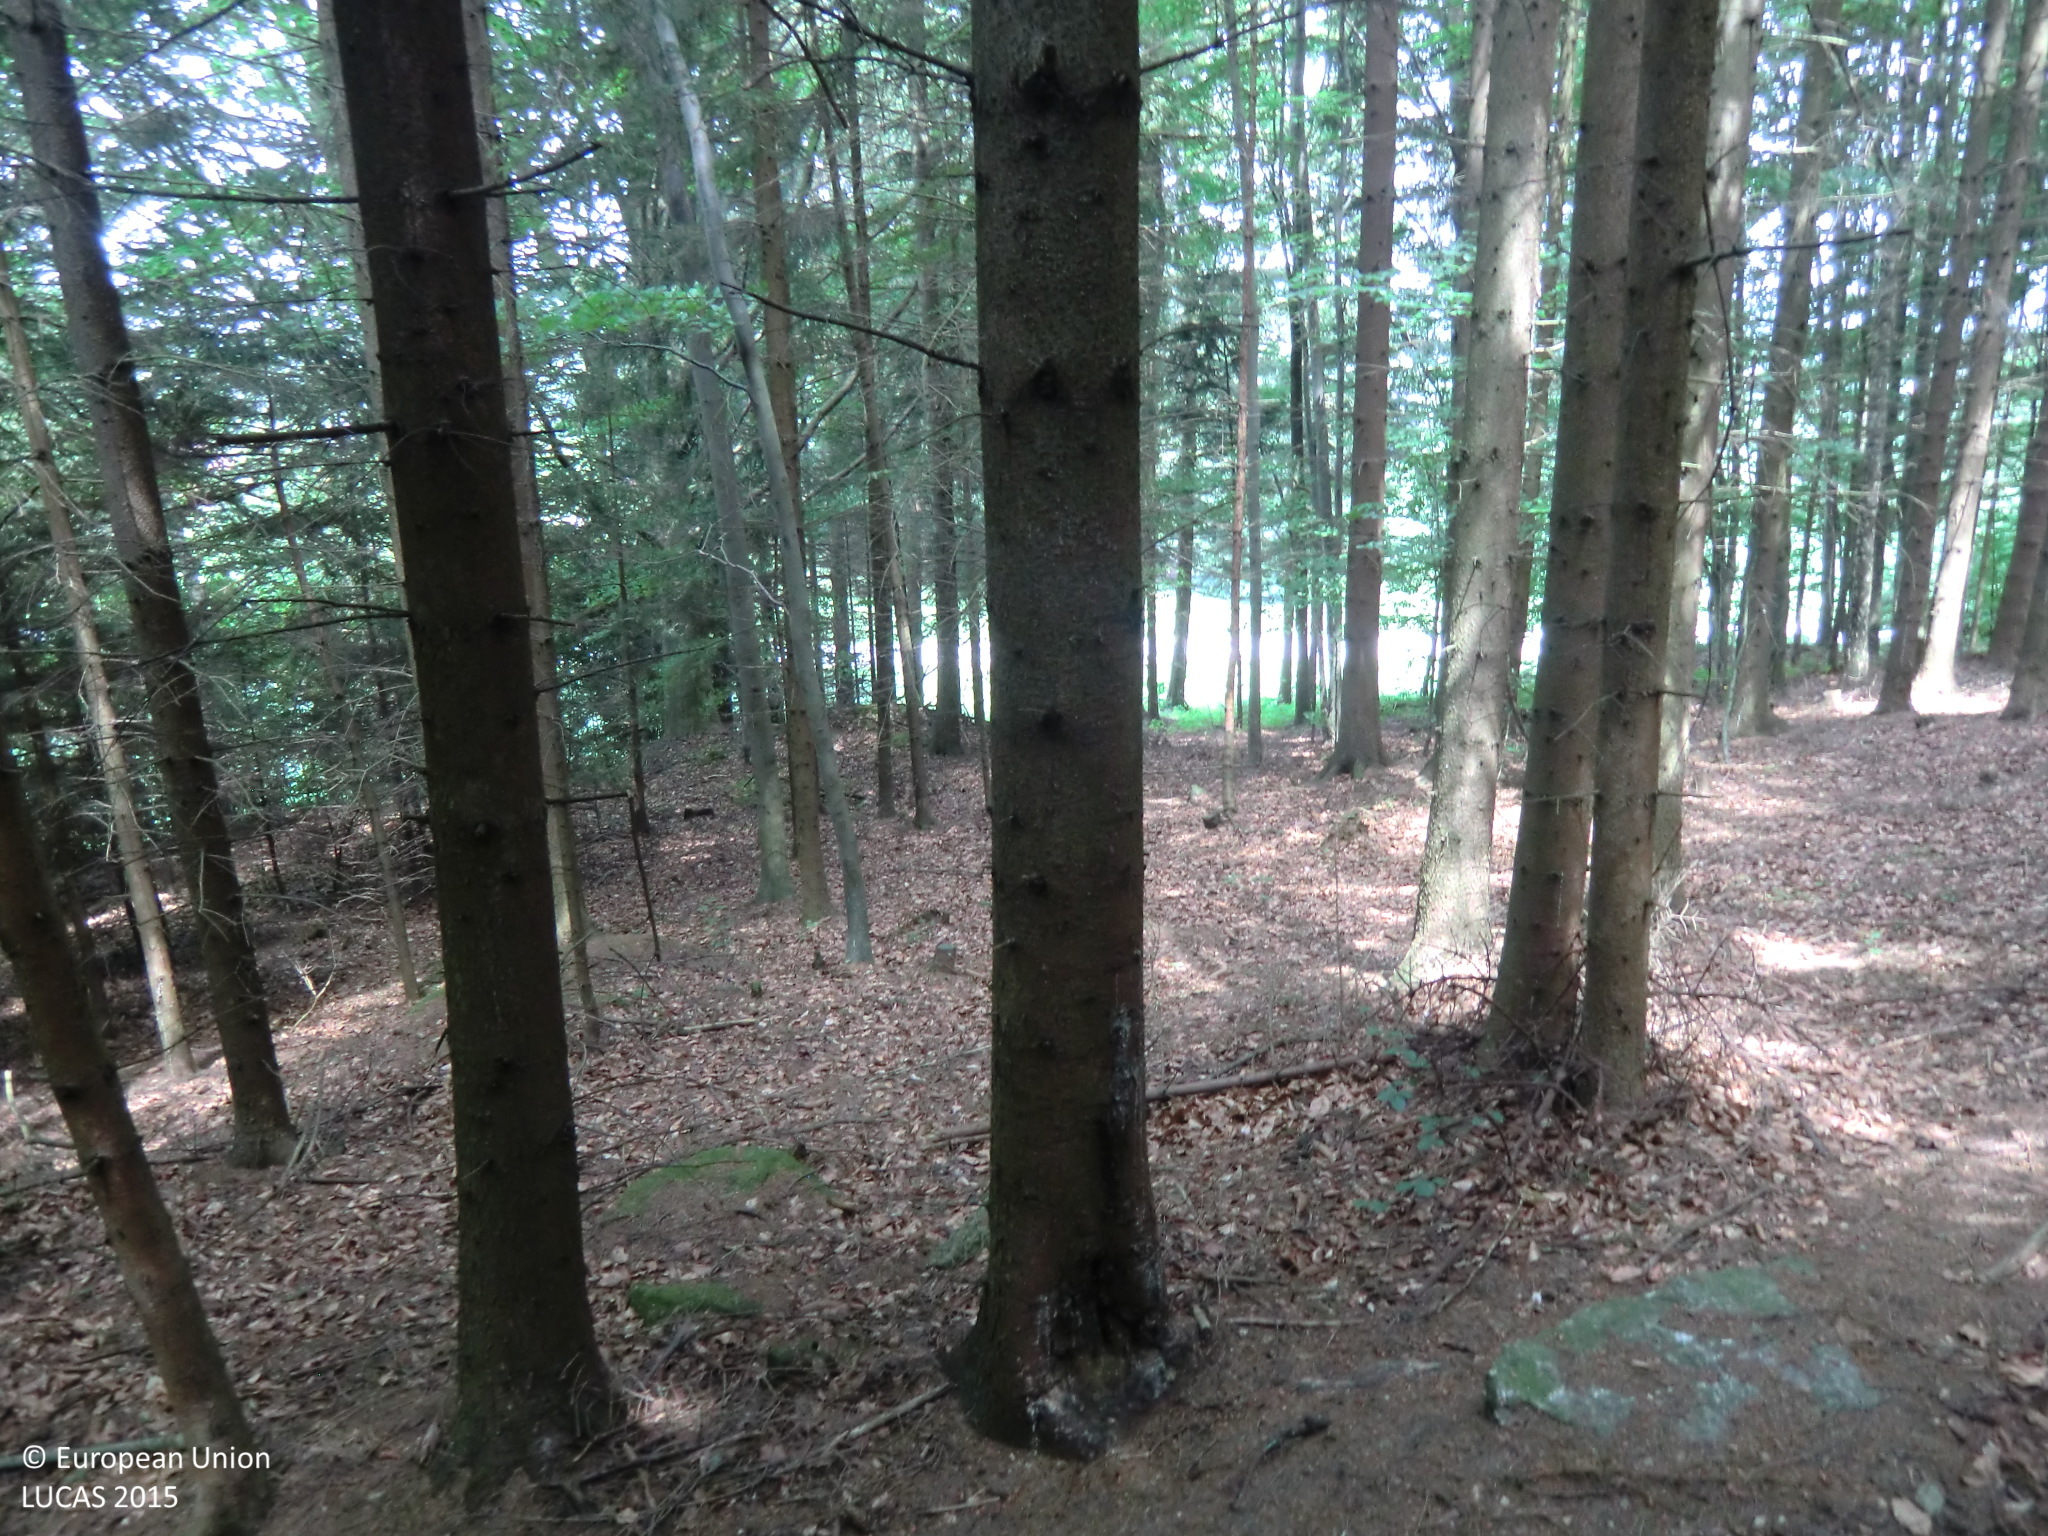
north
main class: Woodland
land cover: Spruce dominated mixed woodland
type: hemiboreal forest and nemoral coniferous forest and mixed broadleaved-coniferous forest
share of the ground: > 75 %
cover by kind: coniferous forest trees 65 %, broadleaved forest trees 25 %, unconsolidated bare surface 10 %
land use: Forestry
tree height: > 5 m
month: June
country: AT
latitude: 48.6146
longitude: 15.0070
